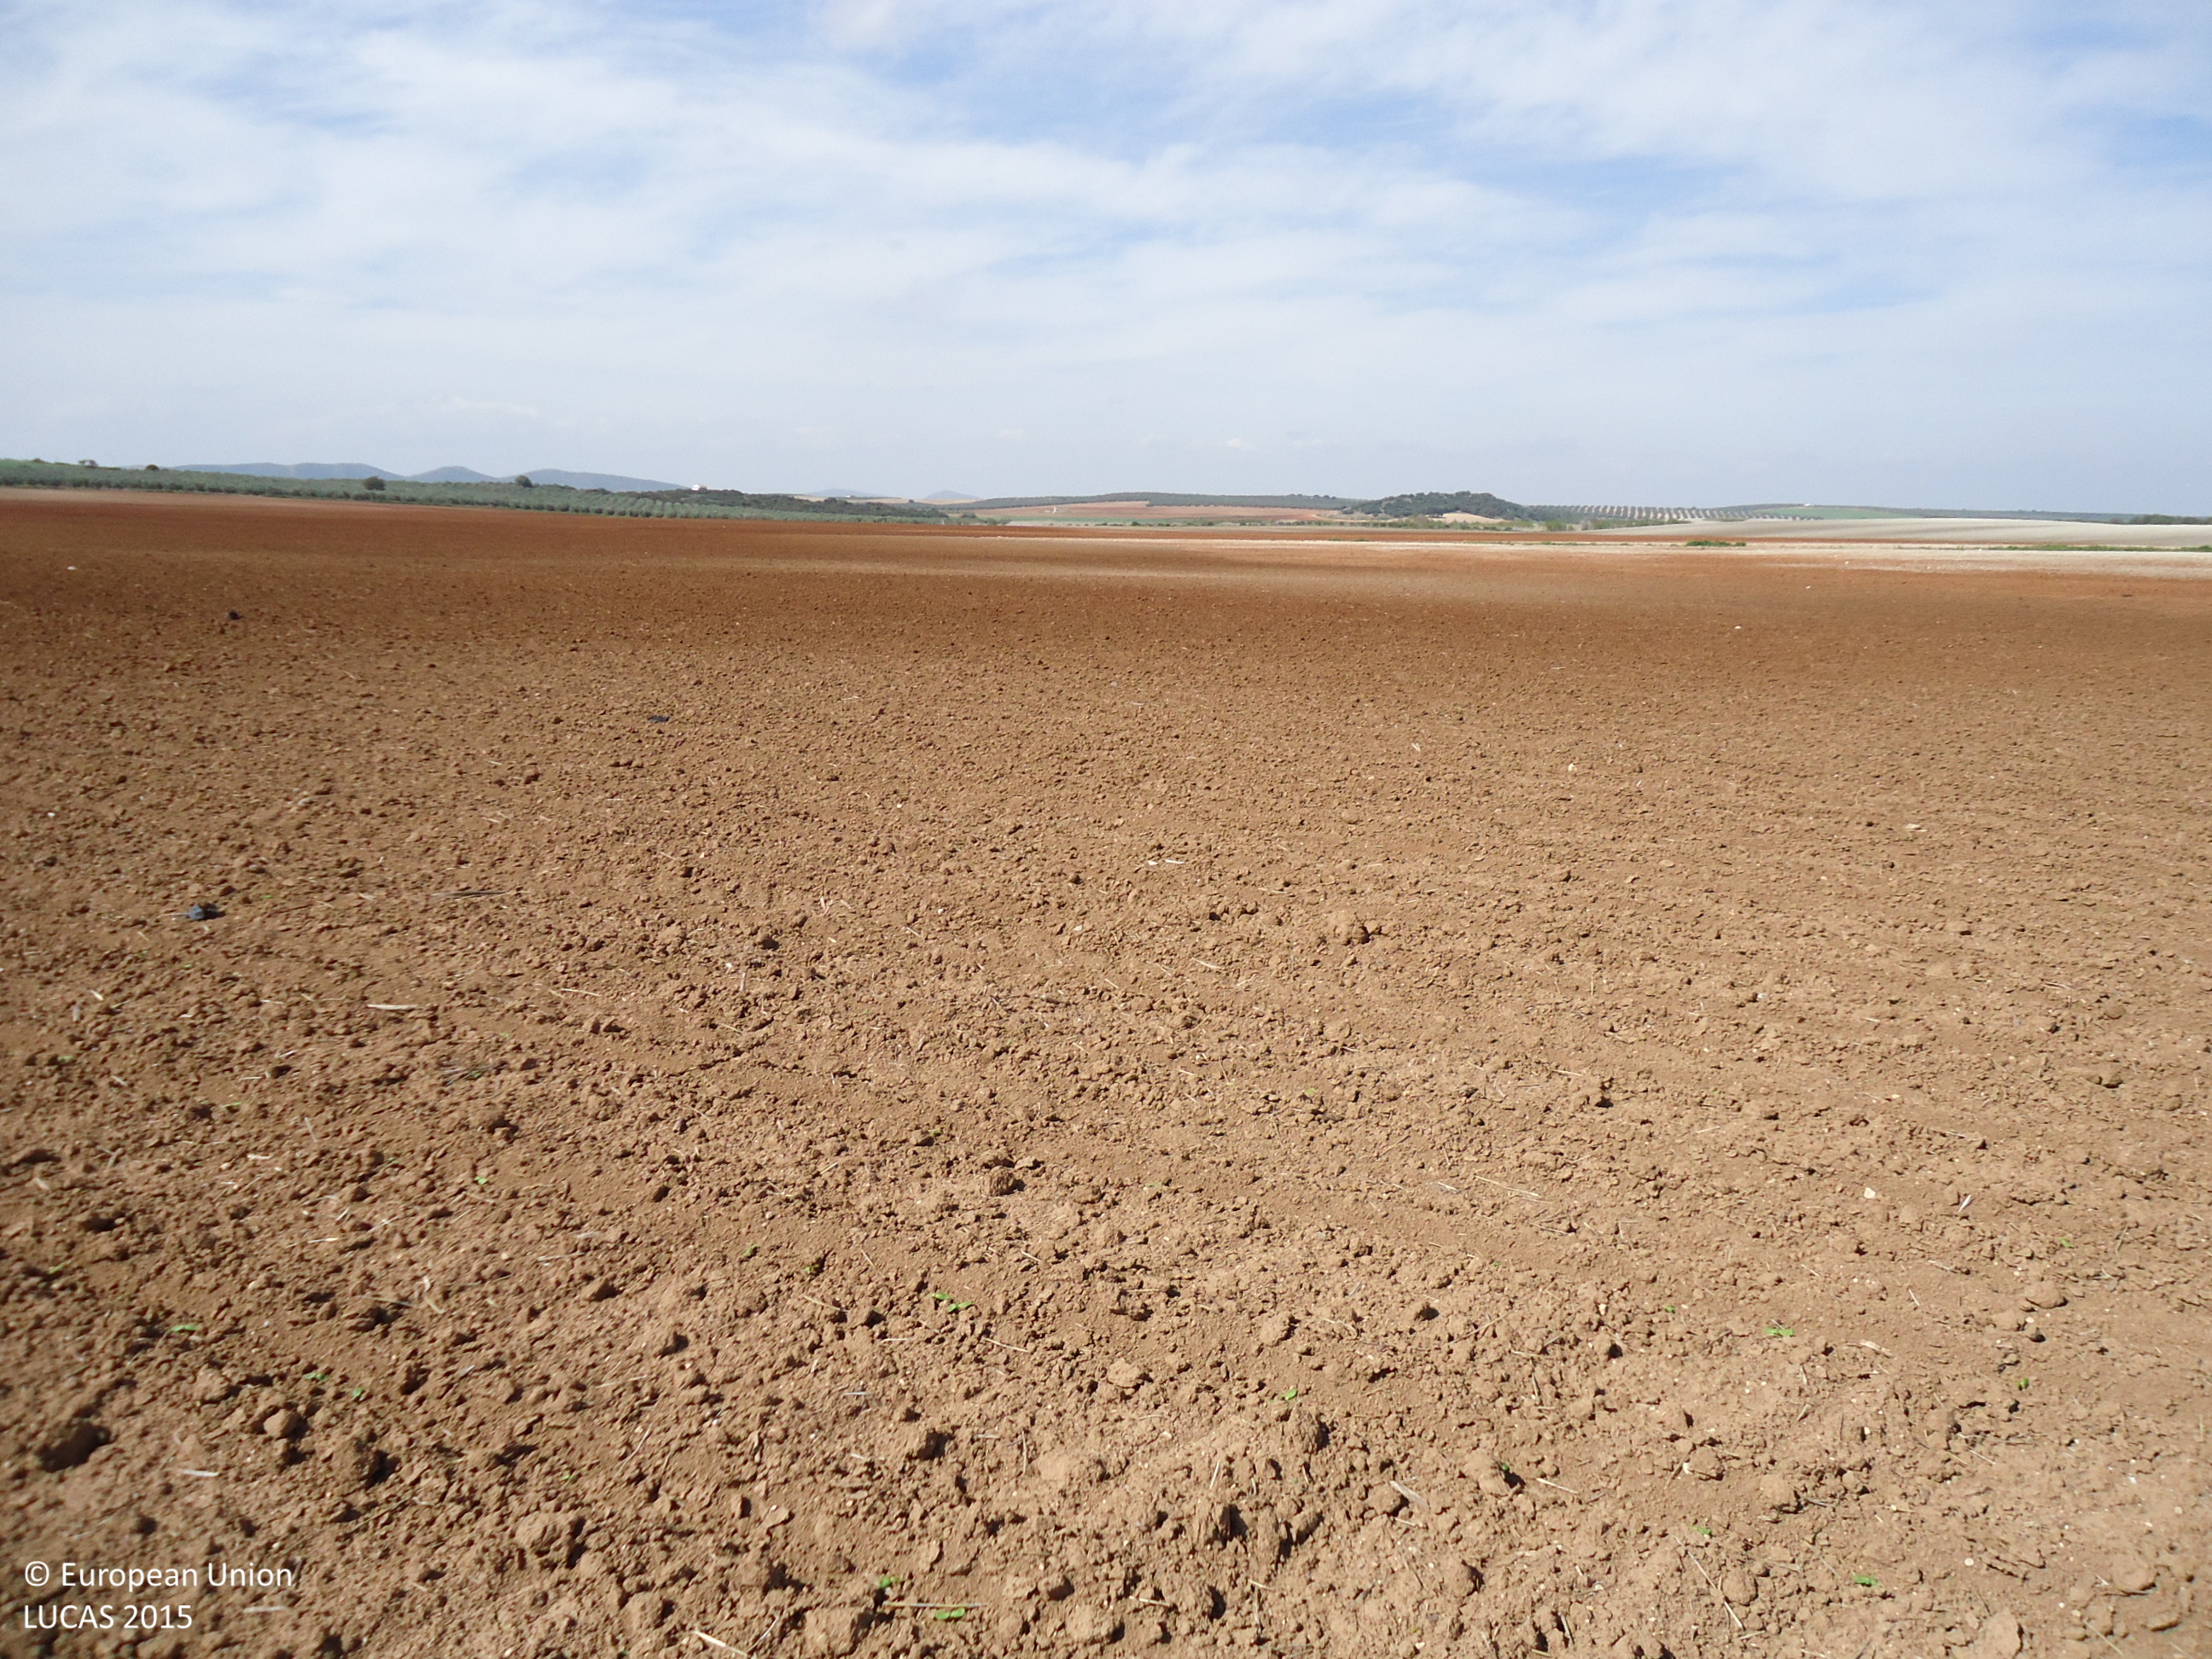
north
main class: Cropland
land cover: Sunflower
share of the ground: < 10 %
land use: Agriculture (excluding fallow land and kitchen gardens)
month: April
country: ES
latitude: 37.0983
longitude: -4.7967
